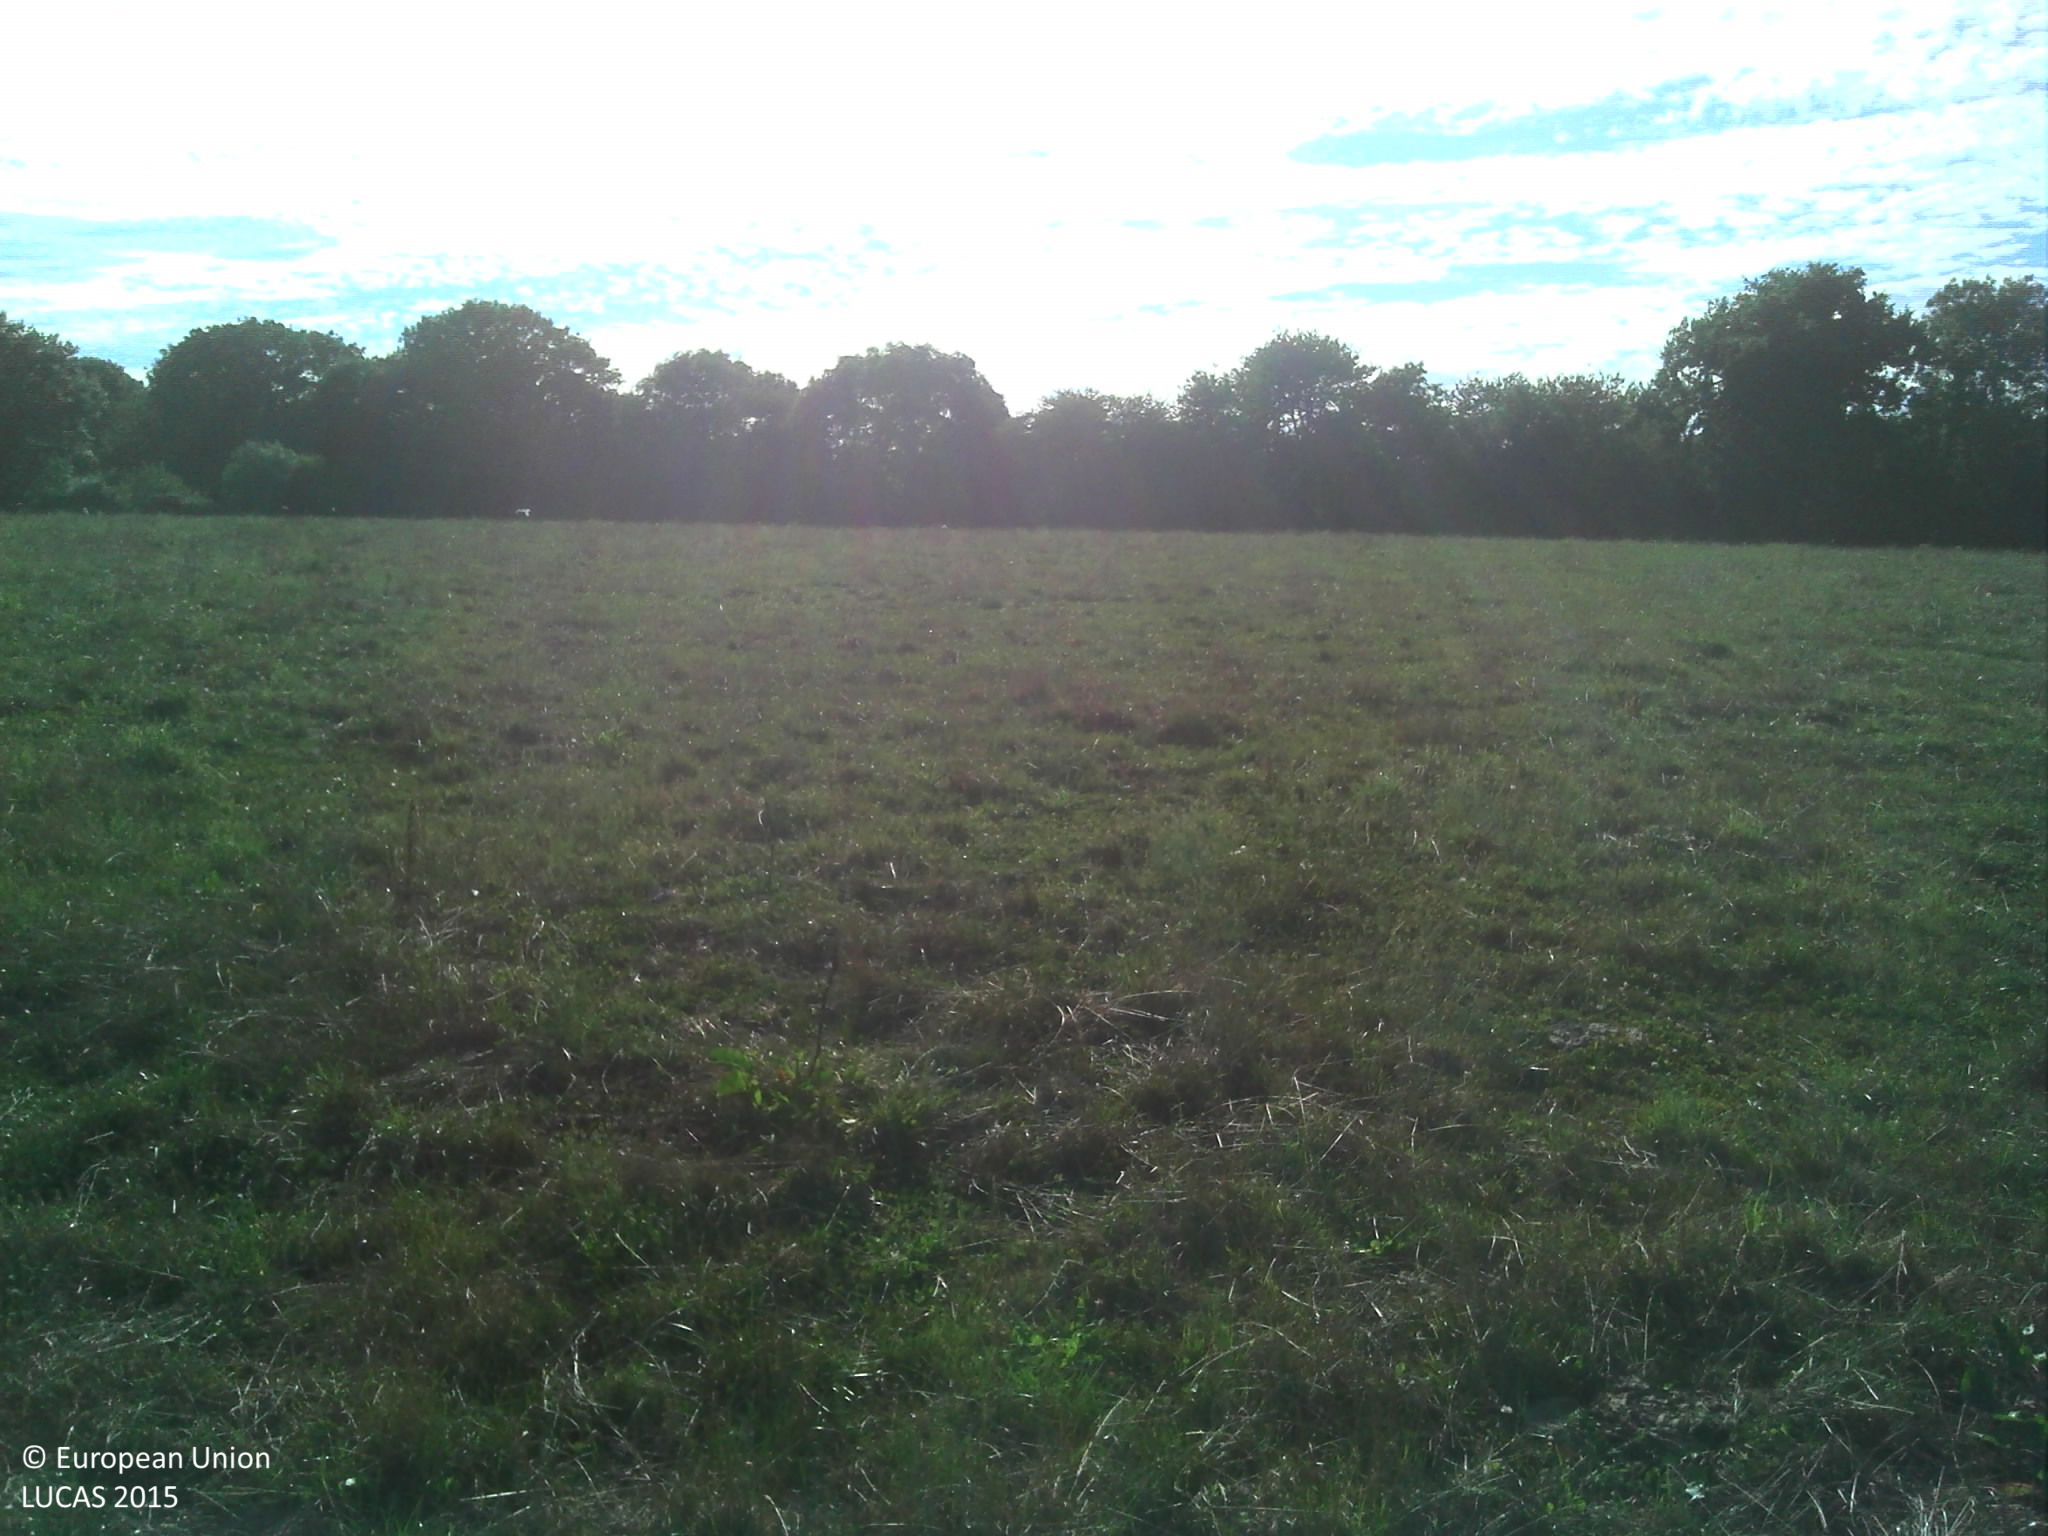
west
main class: Grassland
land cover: Grassland without tree/shrub cover
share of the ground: > 75 %
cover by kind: herbaceous plants 100 %
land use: Agriculture (excluding fallow land and kitchen gardens)
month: August
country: FR
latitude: 46.6515
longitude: -1.7097
